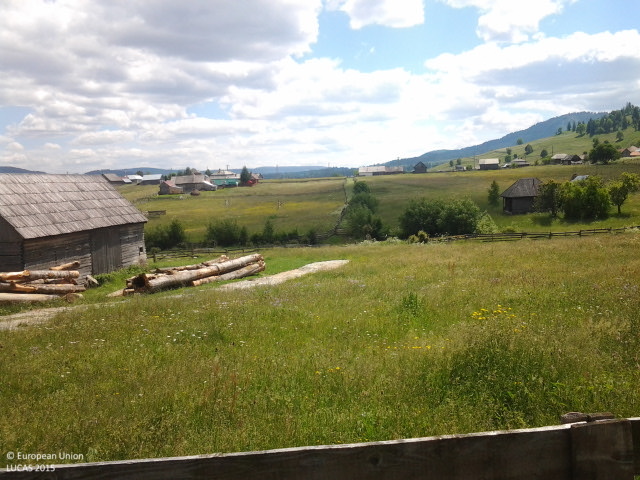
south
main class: Grassland
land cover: Grassland without tree/shrub cover
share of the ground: > 75 %
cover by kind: herbaceous plants 100 %
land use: Agriculture (excluding fallow land and kitchen gardens)
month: June
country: RO
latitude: 47.0666
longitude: 25.4790
